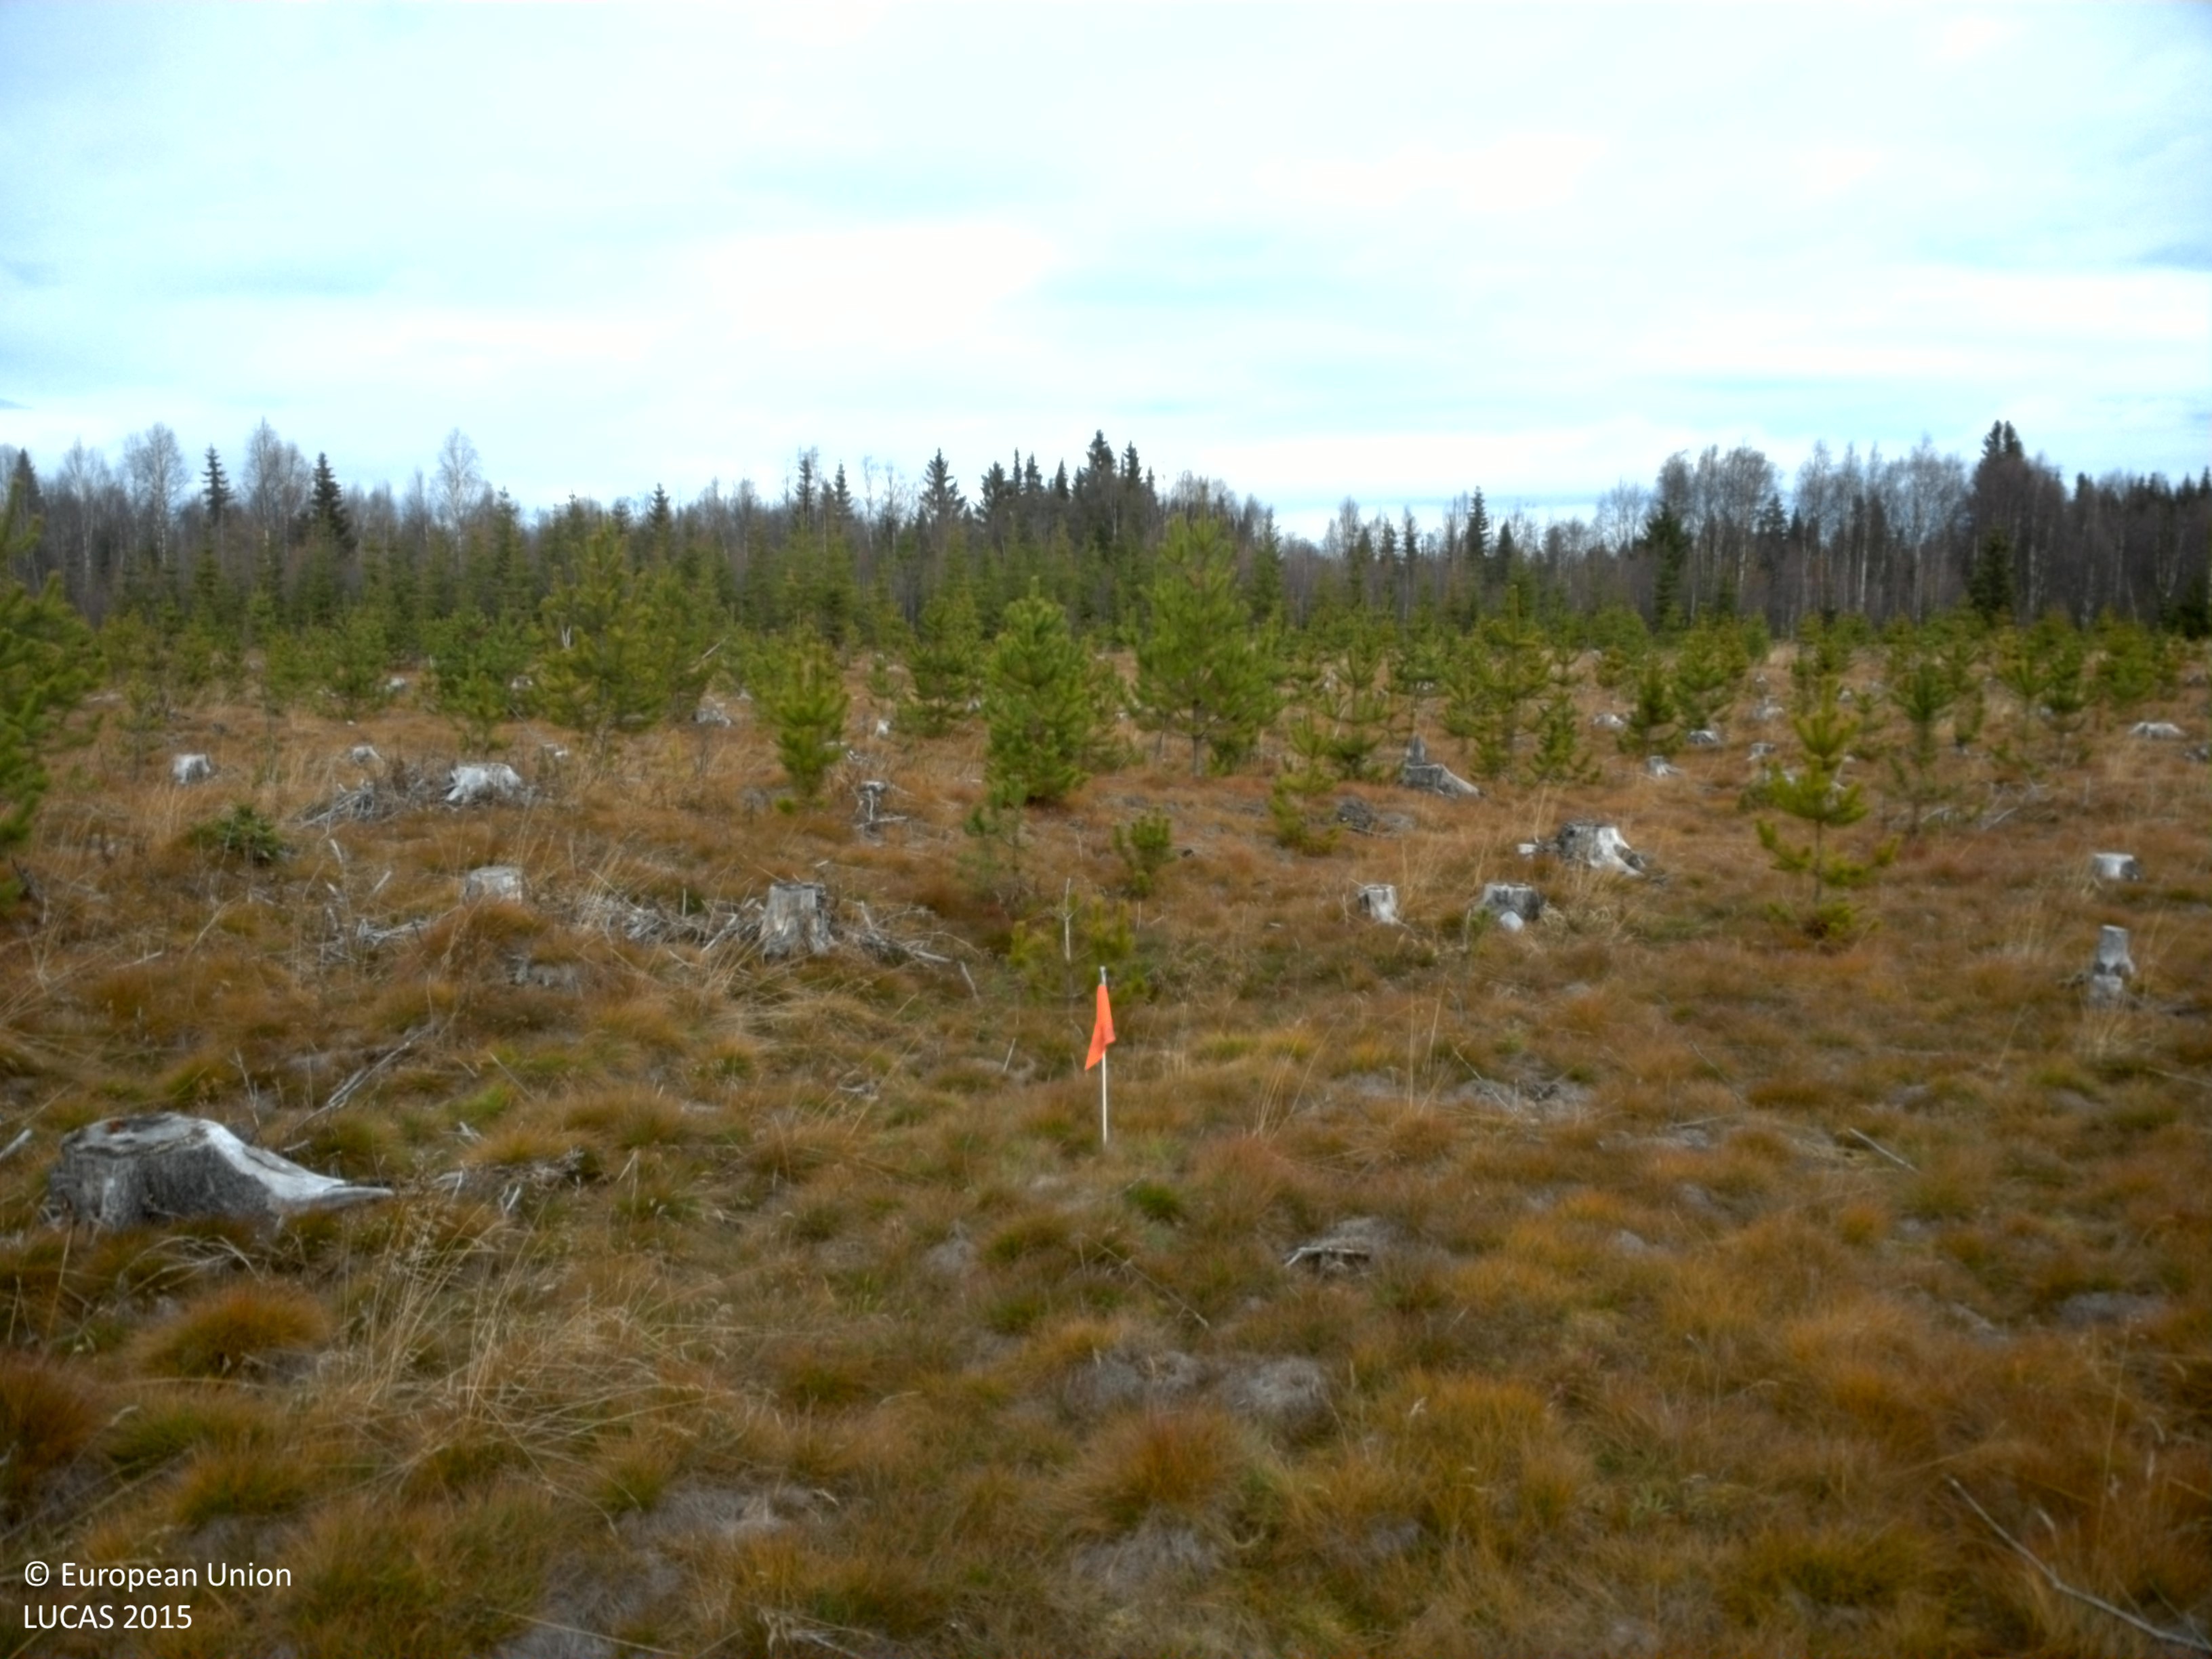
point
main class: Woodland
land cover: Pine dominated coniferous woodland
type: exotic forest
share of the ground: 10 - 25 %
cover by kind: herbaceous plants 85 %, coniferous forest trees 10 %, lichens and mosses 5 %
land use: Forestry
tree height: < 5 m
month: October
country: SE
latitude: 64.5764
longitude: 16.4184
